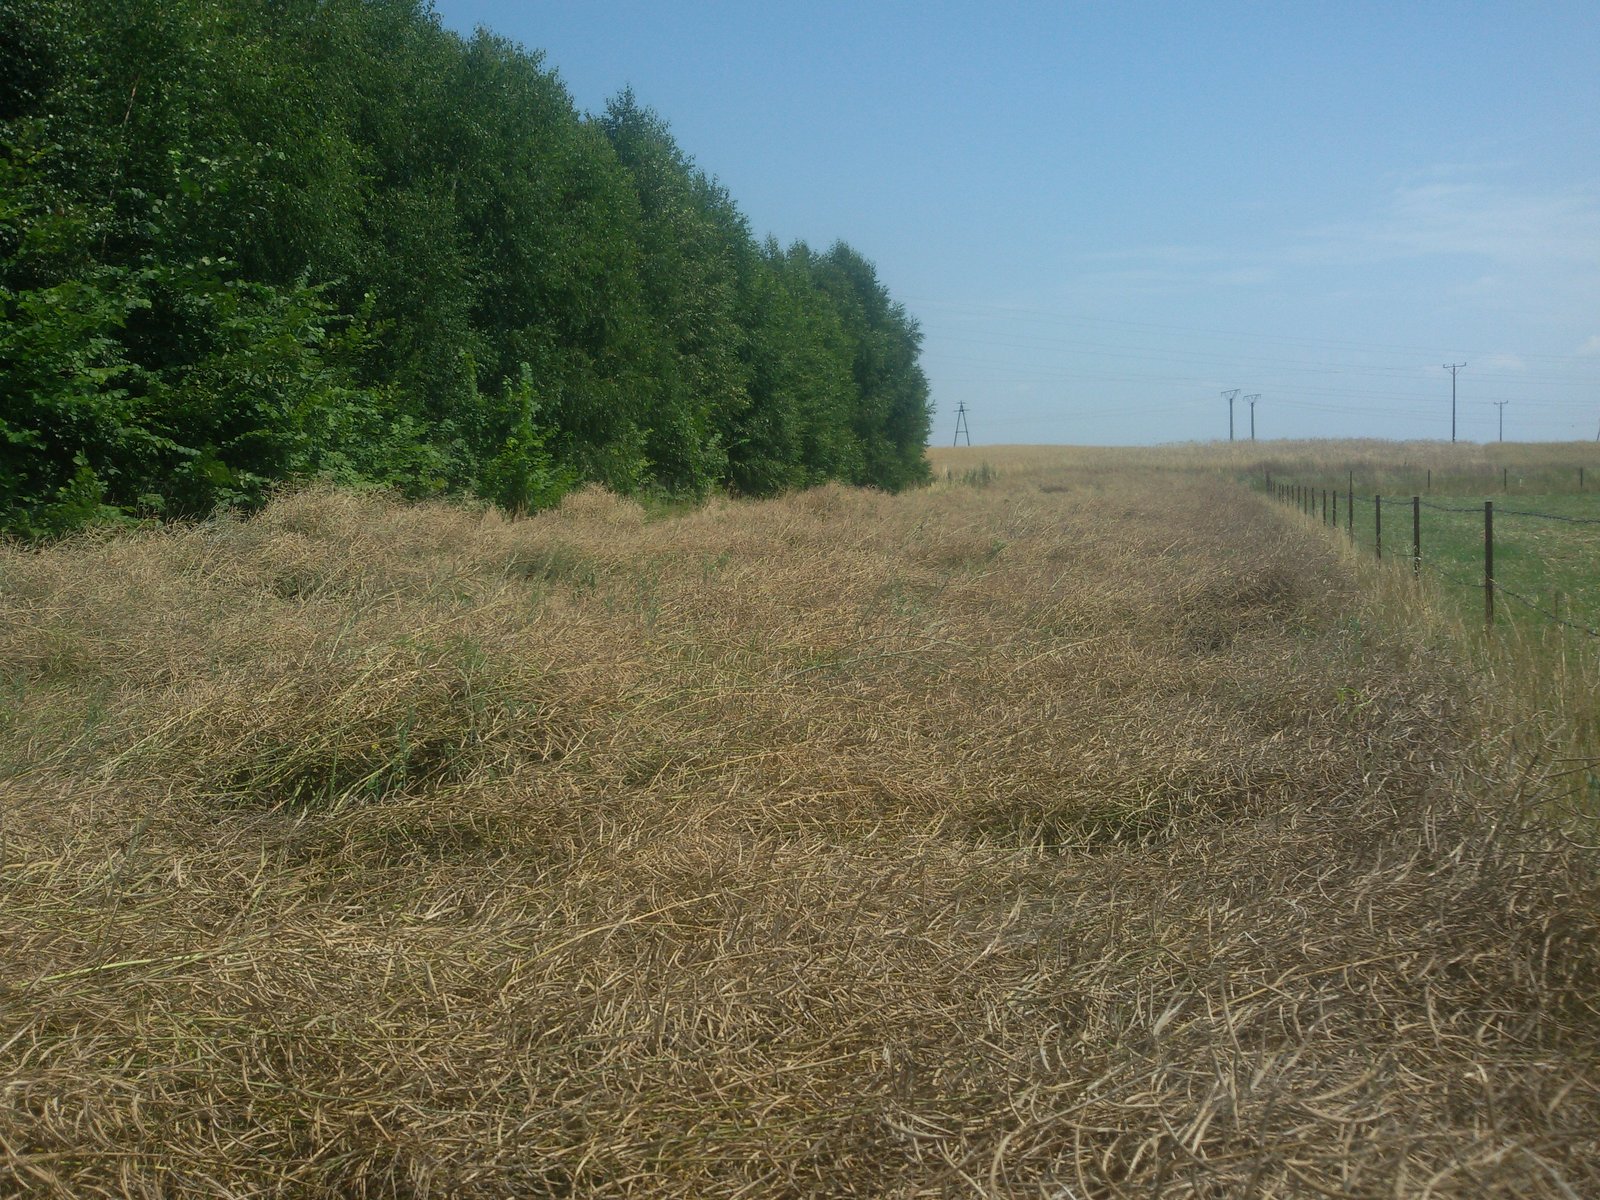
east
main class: Cropland
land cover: Rape and turnip rape
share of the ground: > 75 %
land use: Agriculture (excluding fallow land and kitchen gardens)
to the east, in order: Rape and turnip rape; Broadleaved woodland; Grass margins; Tracks; Grass margins; Mixed cereals for fodder; Barley; Electric lines; Barley; Common wheat; Electric lines; Common wheat; Maize
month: July
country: PL
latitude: 50.3042
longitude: 22.4054
